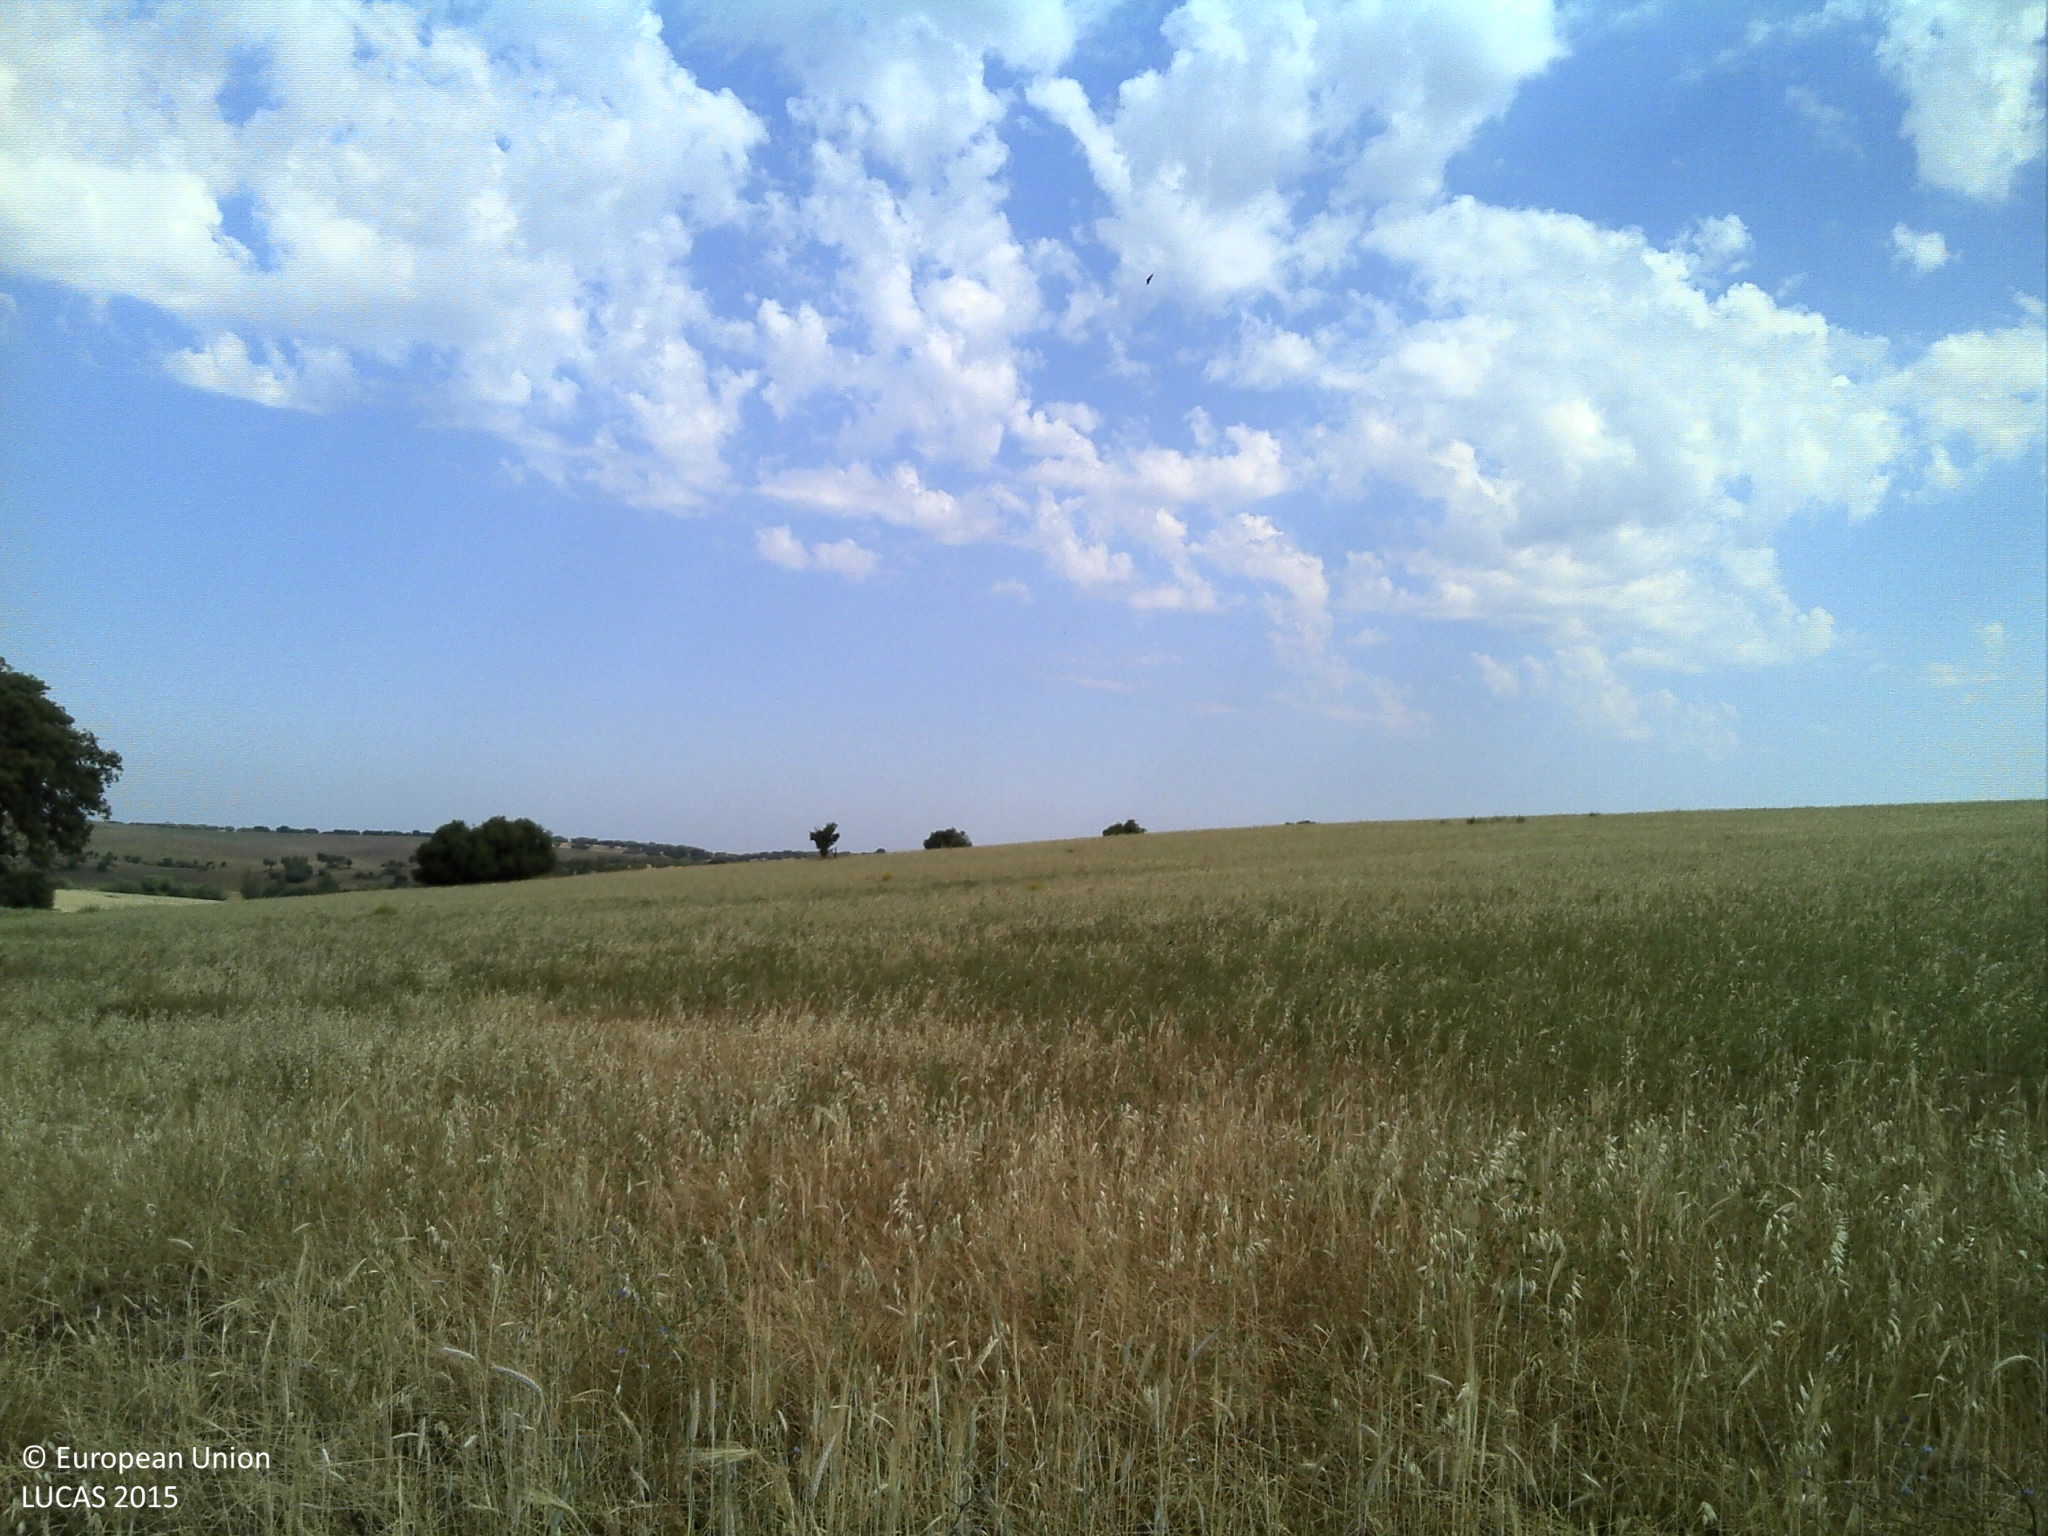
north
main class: Cropland
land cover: Triticale
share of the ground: > 75 %
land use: Agriculture (excluding fallow land and kitchen gardens)
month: May
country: PT
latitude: 38.8828
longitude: -7.9017
